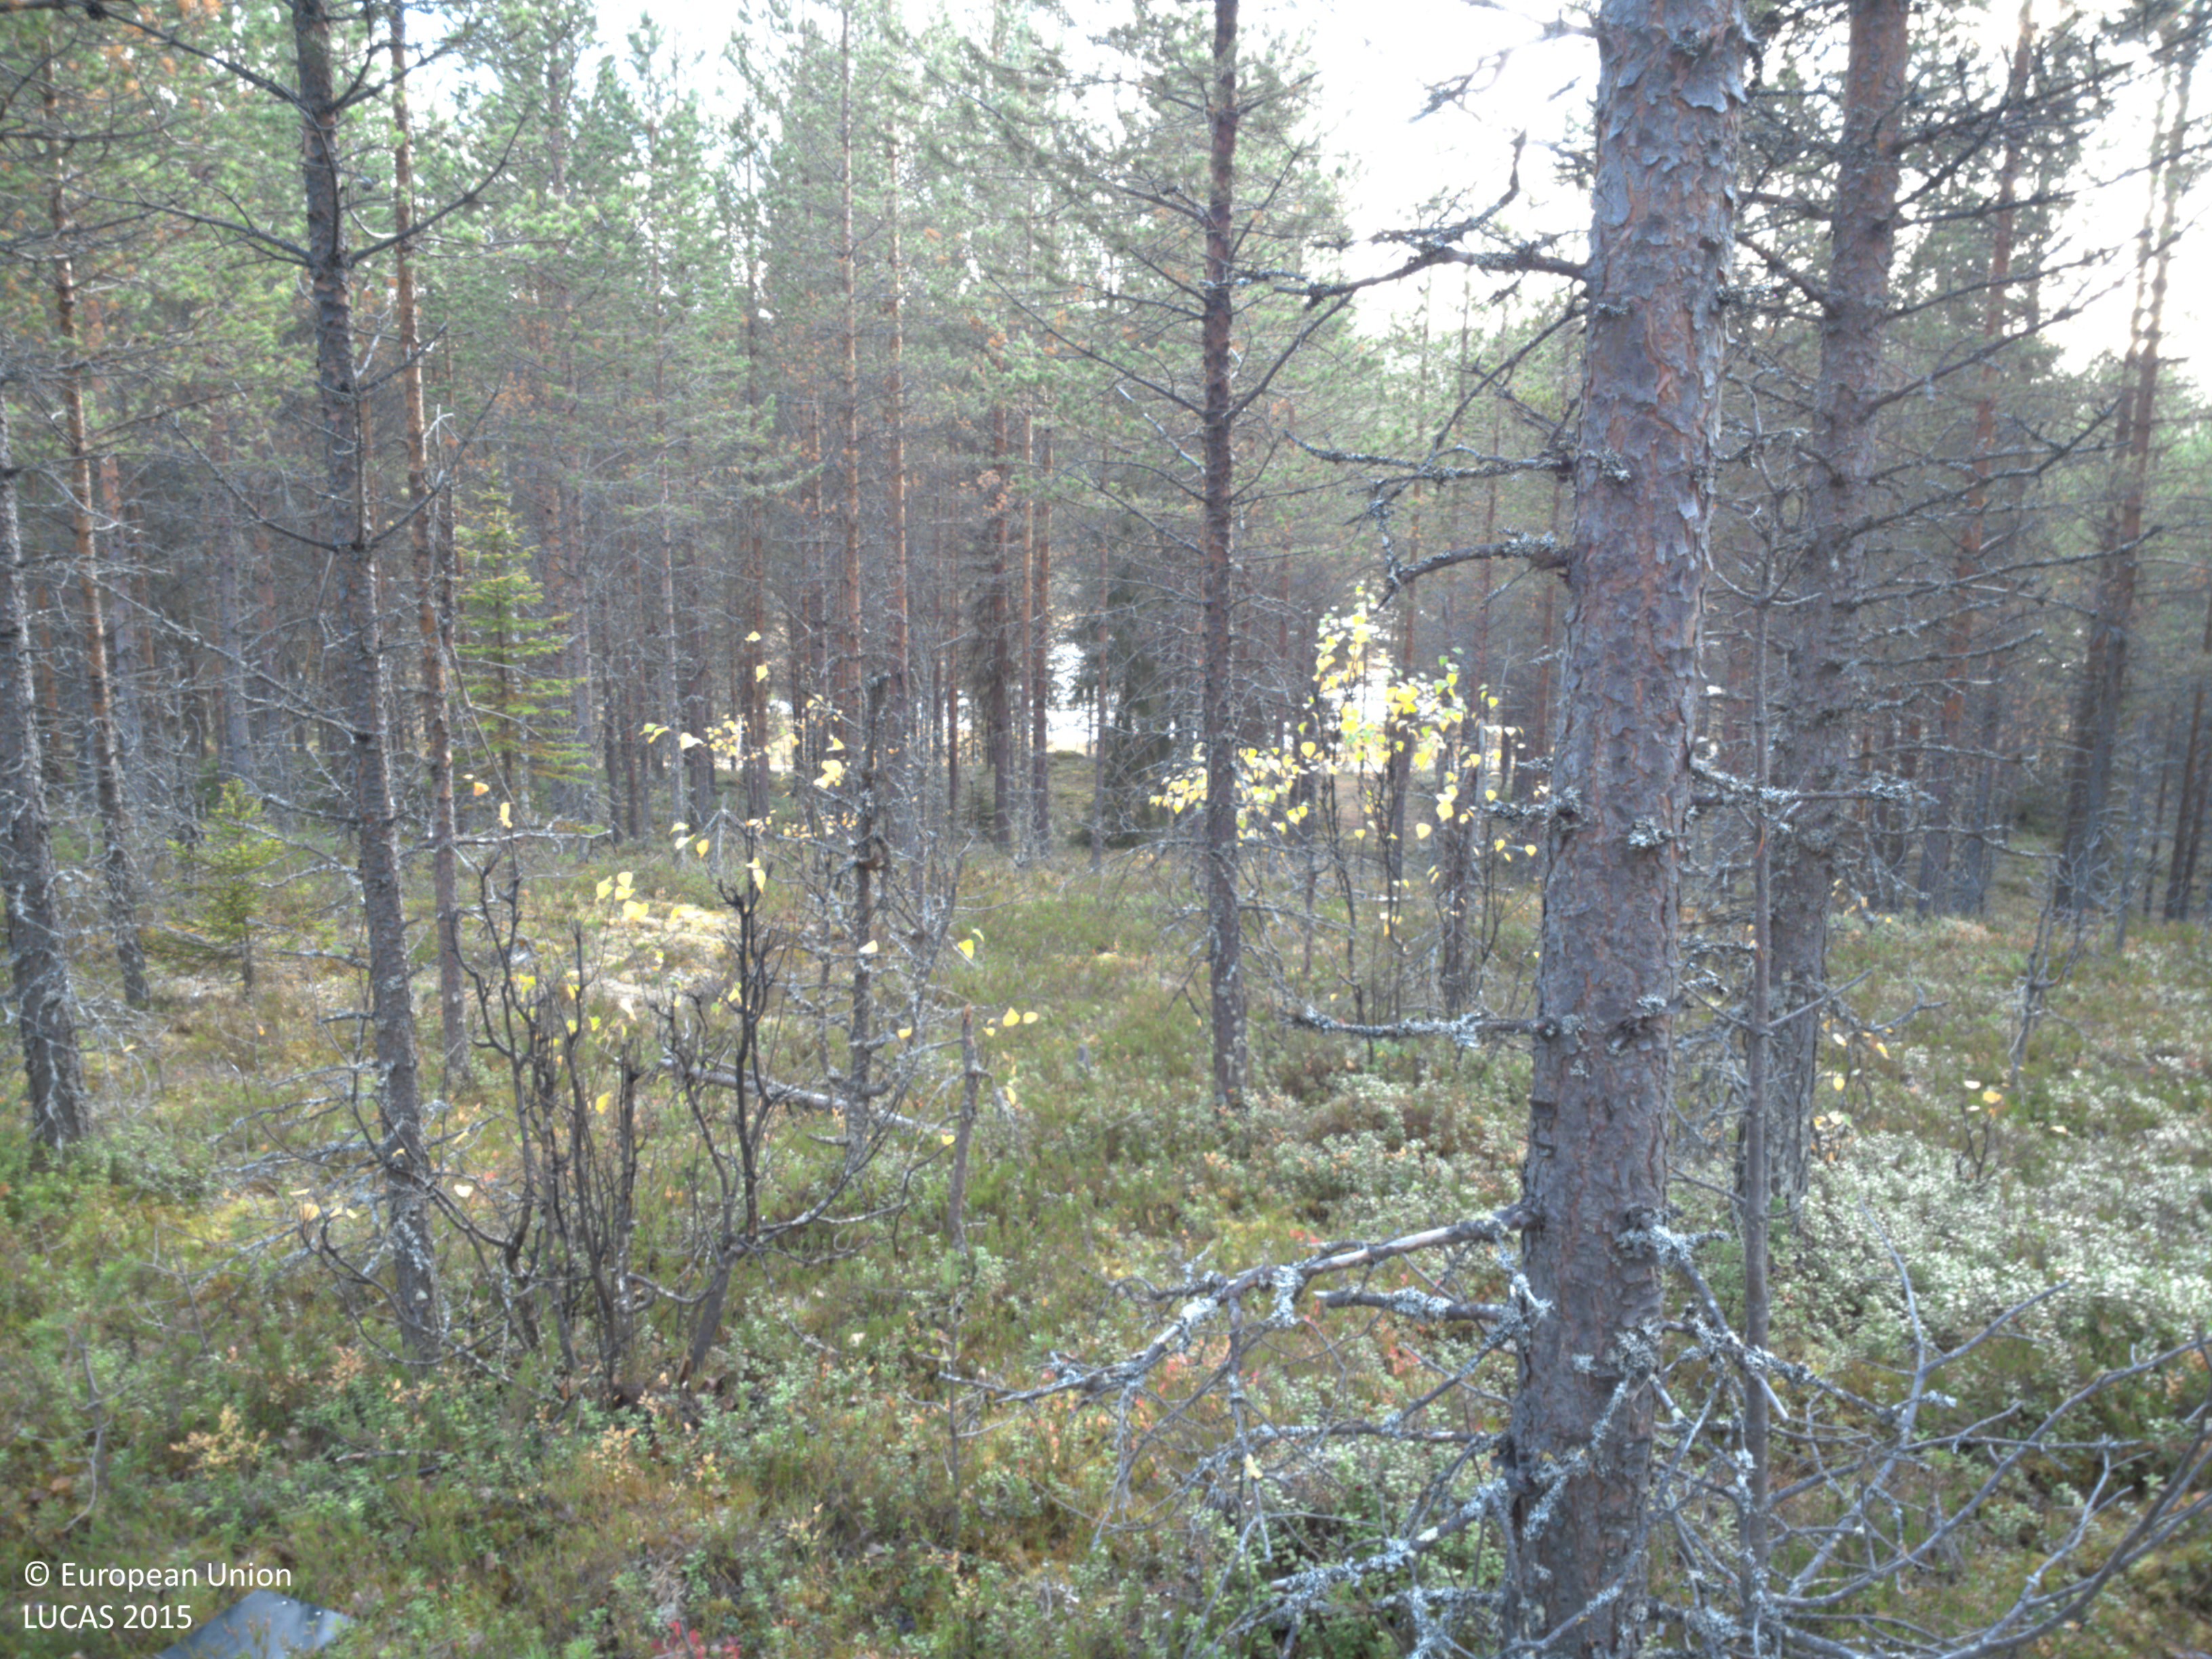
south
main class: Woodland
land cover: Pine dominated coniferous woodland
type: boreal forest
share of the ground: > 75 %
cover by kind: coniferous forest trees 70 %, shrubs 25 %, lichens and mosses 5 %
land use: Forestry
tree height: > 5 m
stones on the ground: < 10 %
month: September
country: SE
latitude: 64.9343
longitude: 18.4902
